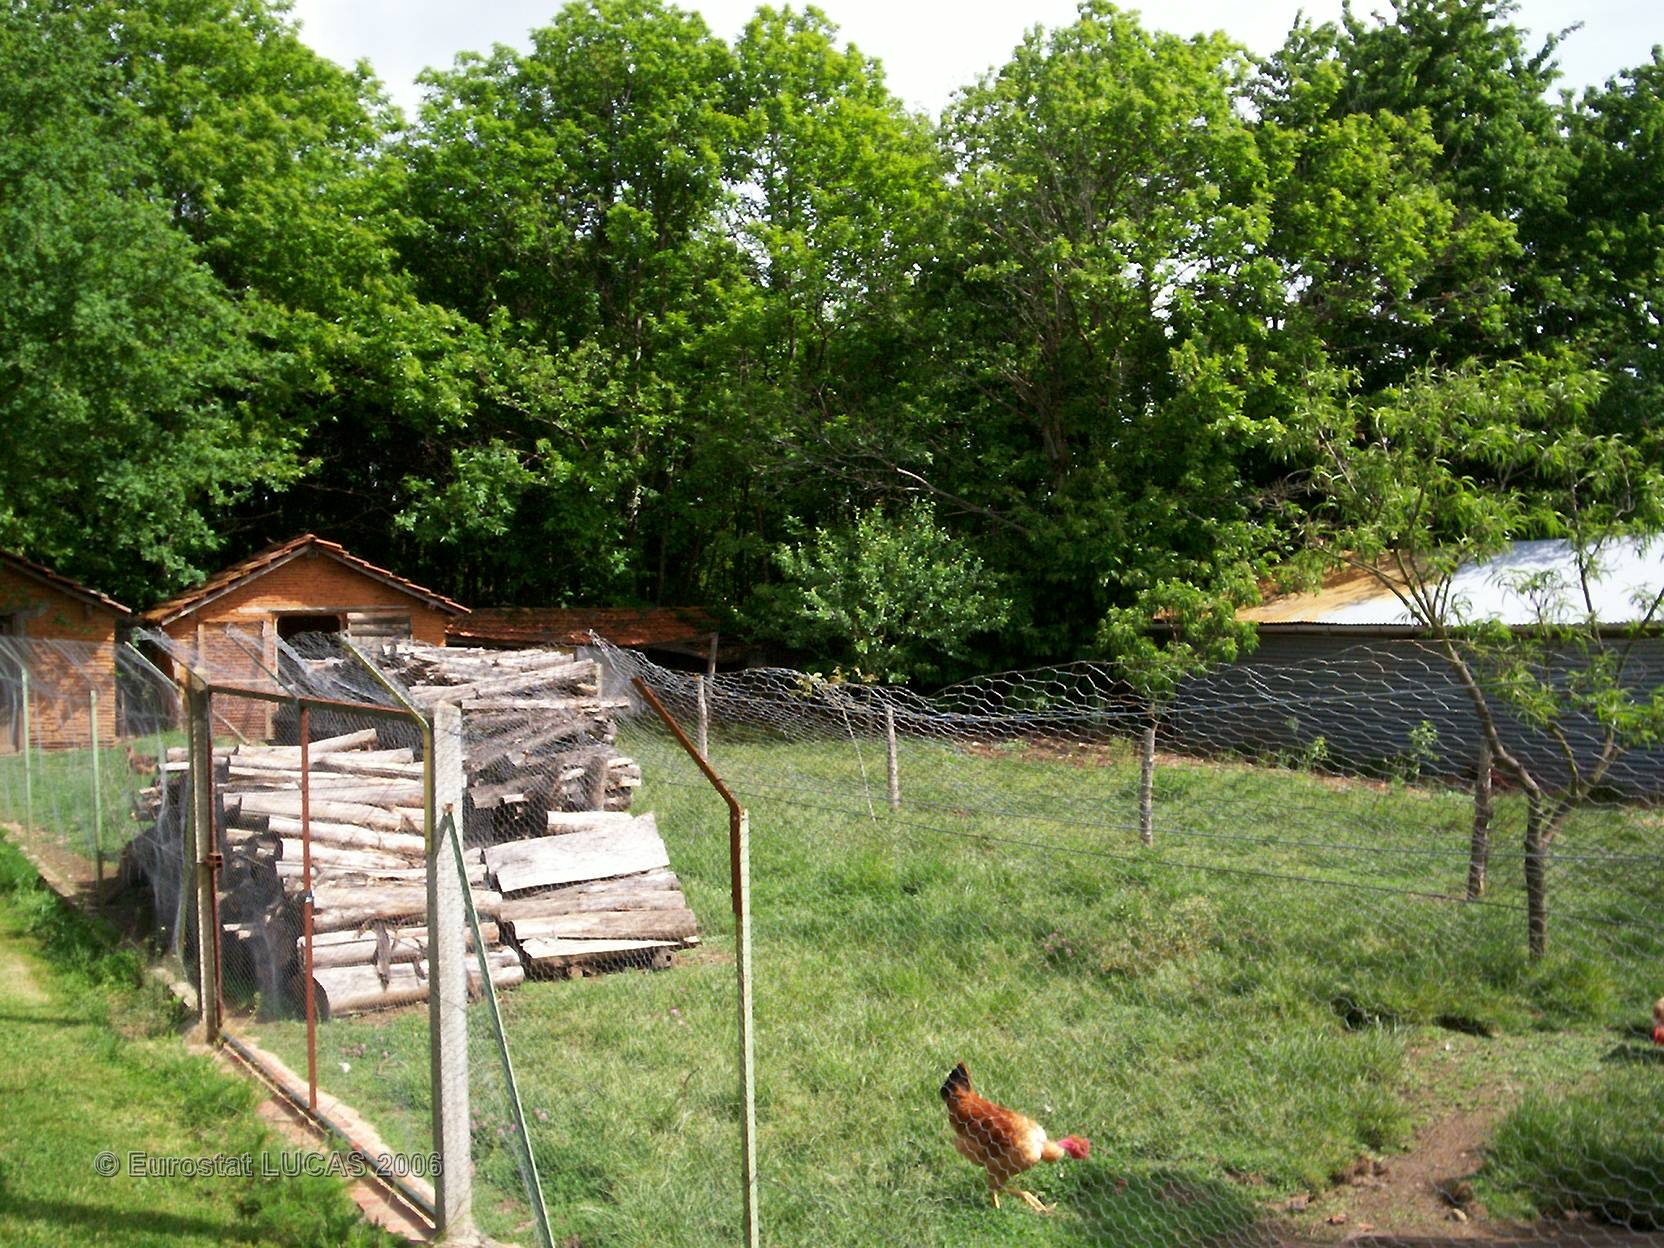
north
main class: Grassland
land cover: Grassland with sparse tree/shrub cover
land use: Residential
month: May
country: FR
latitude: 45.8924
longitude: 0.5130
